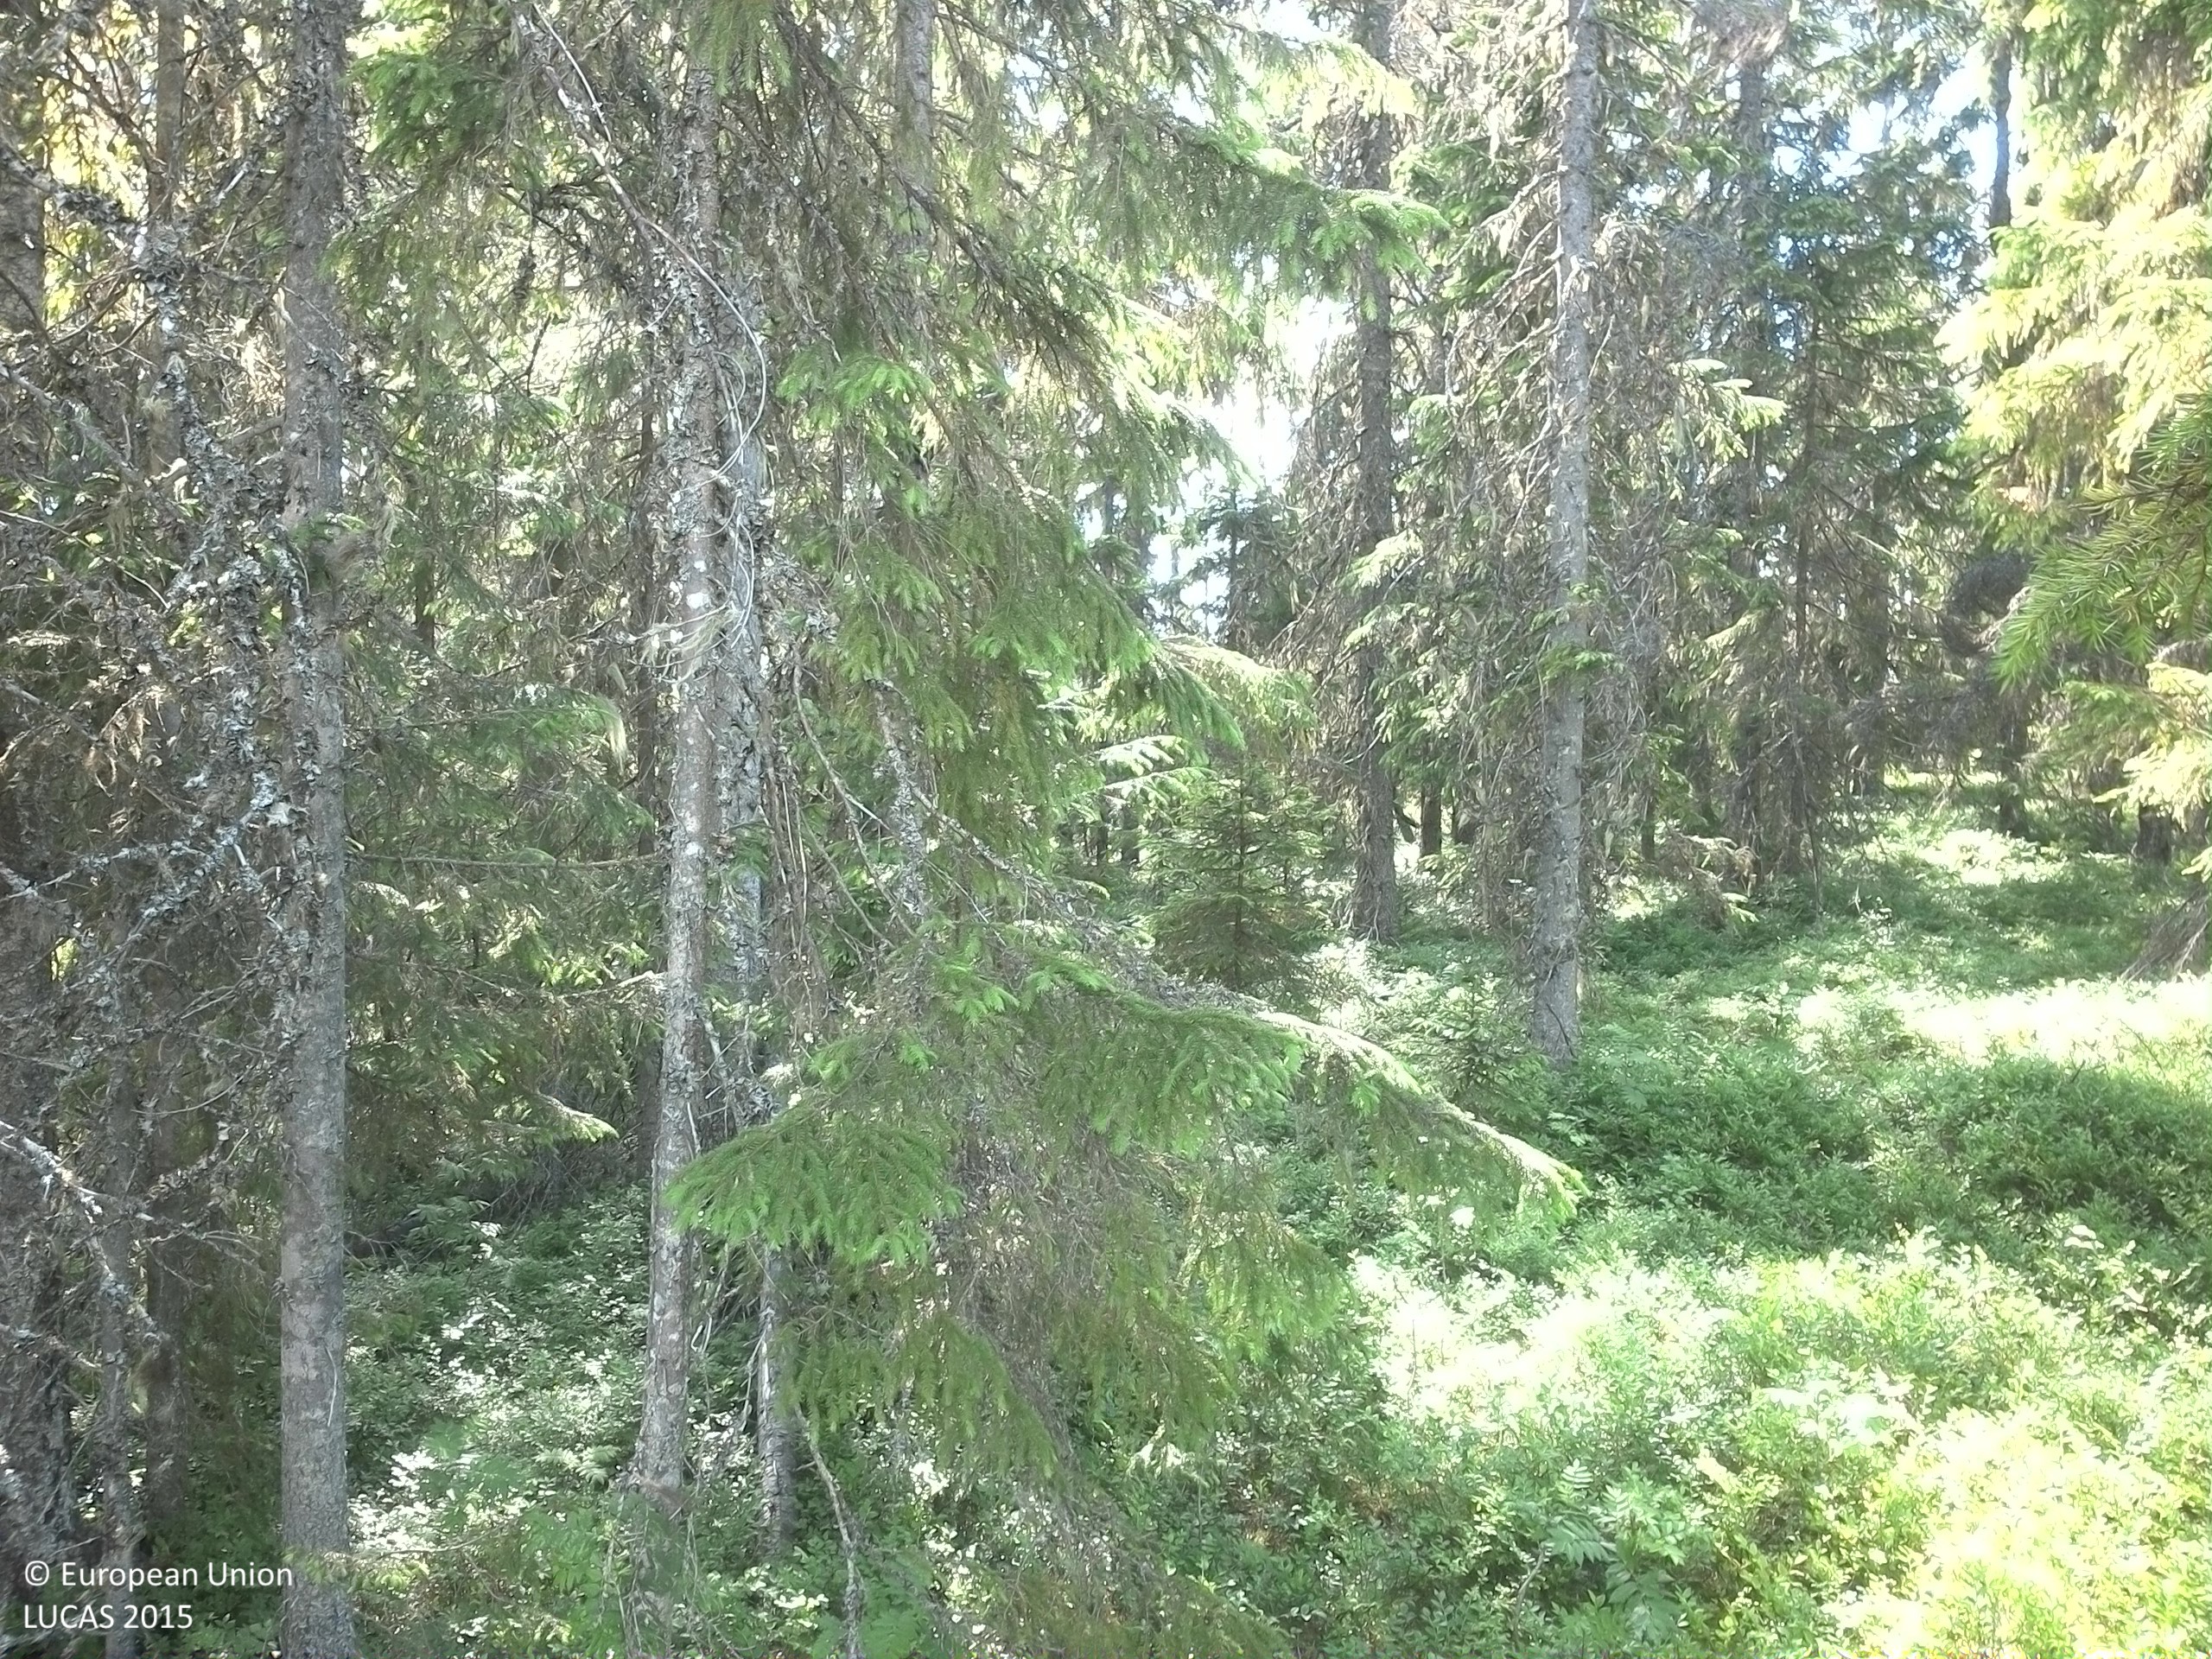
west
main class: Woodland
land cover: Spruce dominated coniferous woodland
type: boreal forest
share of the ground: 50 - 75 %
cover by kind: coniferous forest trees 60 %, shrubs 30 %, broadleaved forest trees 10 %
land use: Forestry
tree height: > 5 m
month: June
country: SE
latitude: 62.8485
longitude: 17.7371
